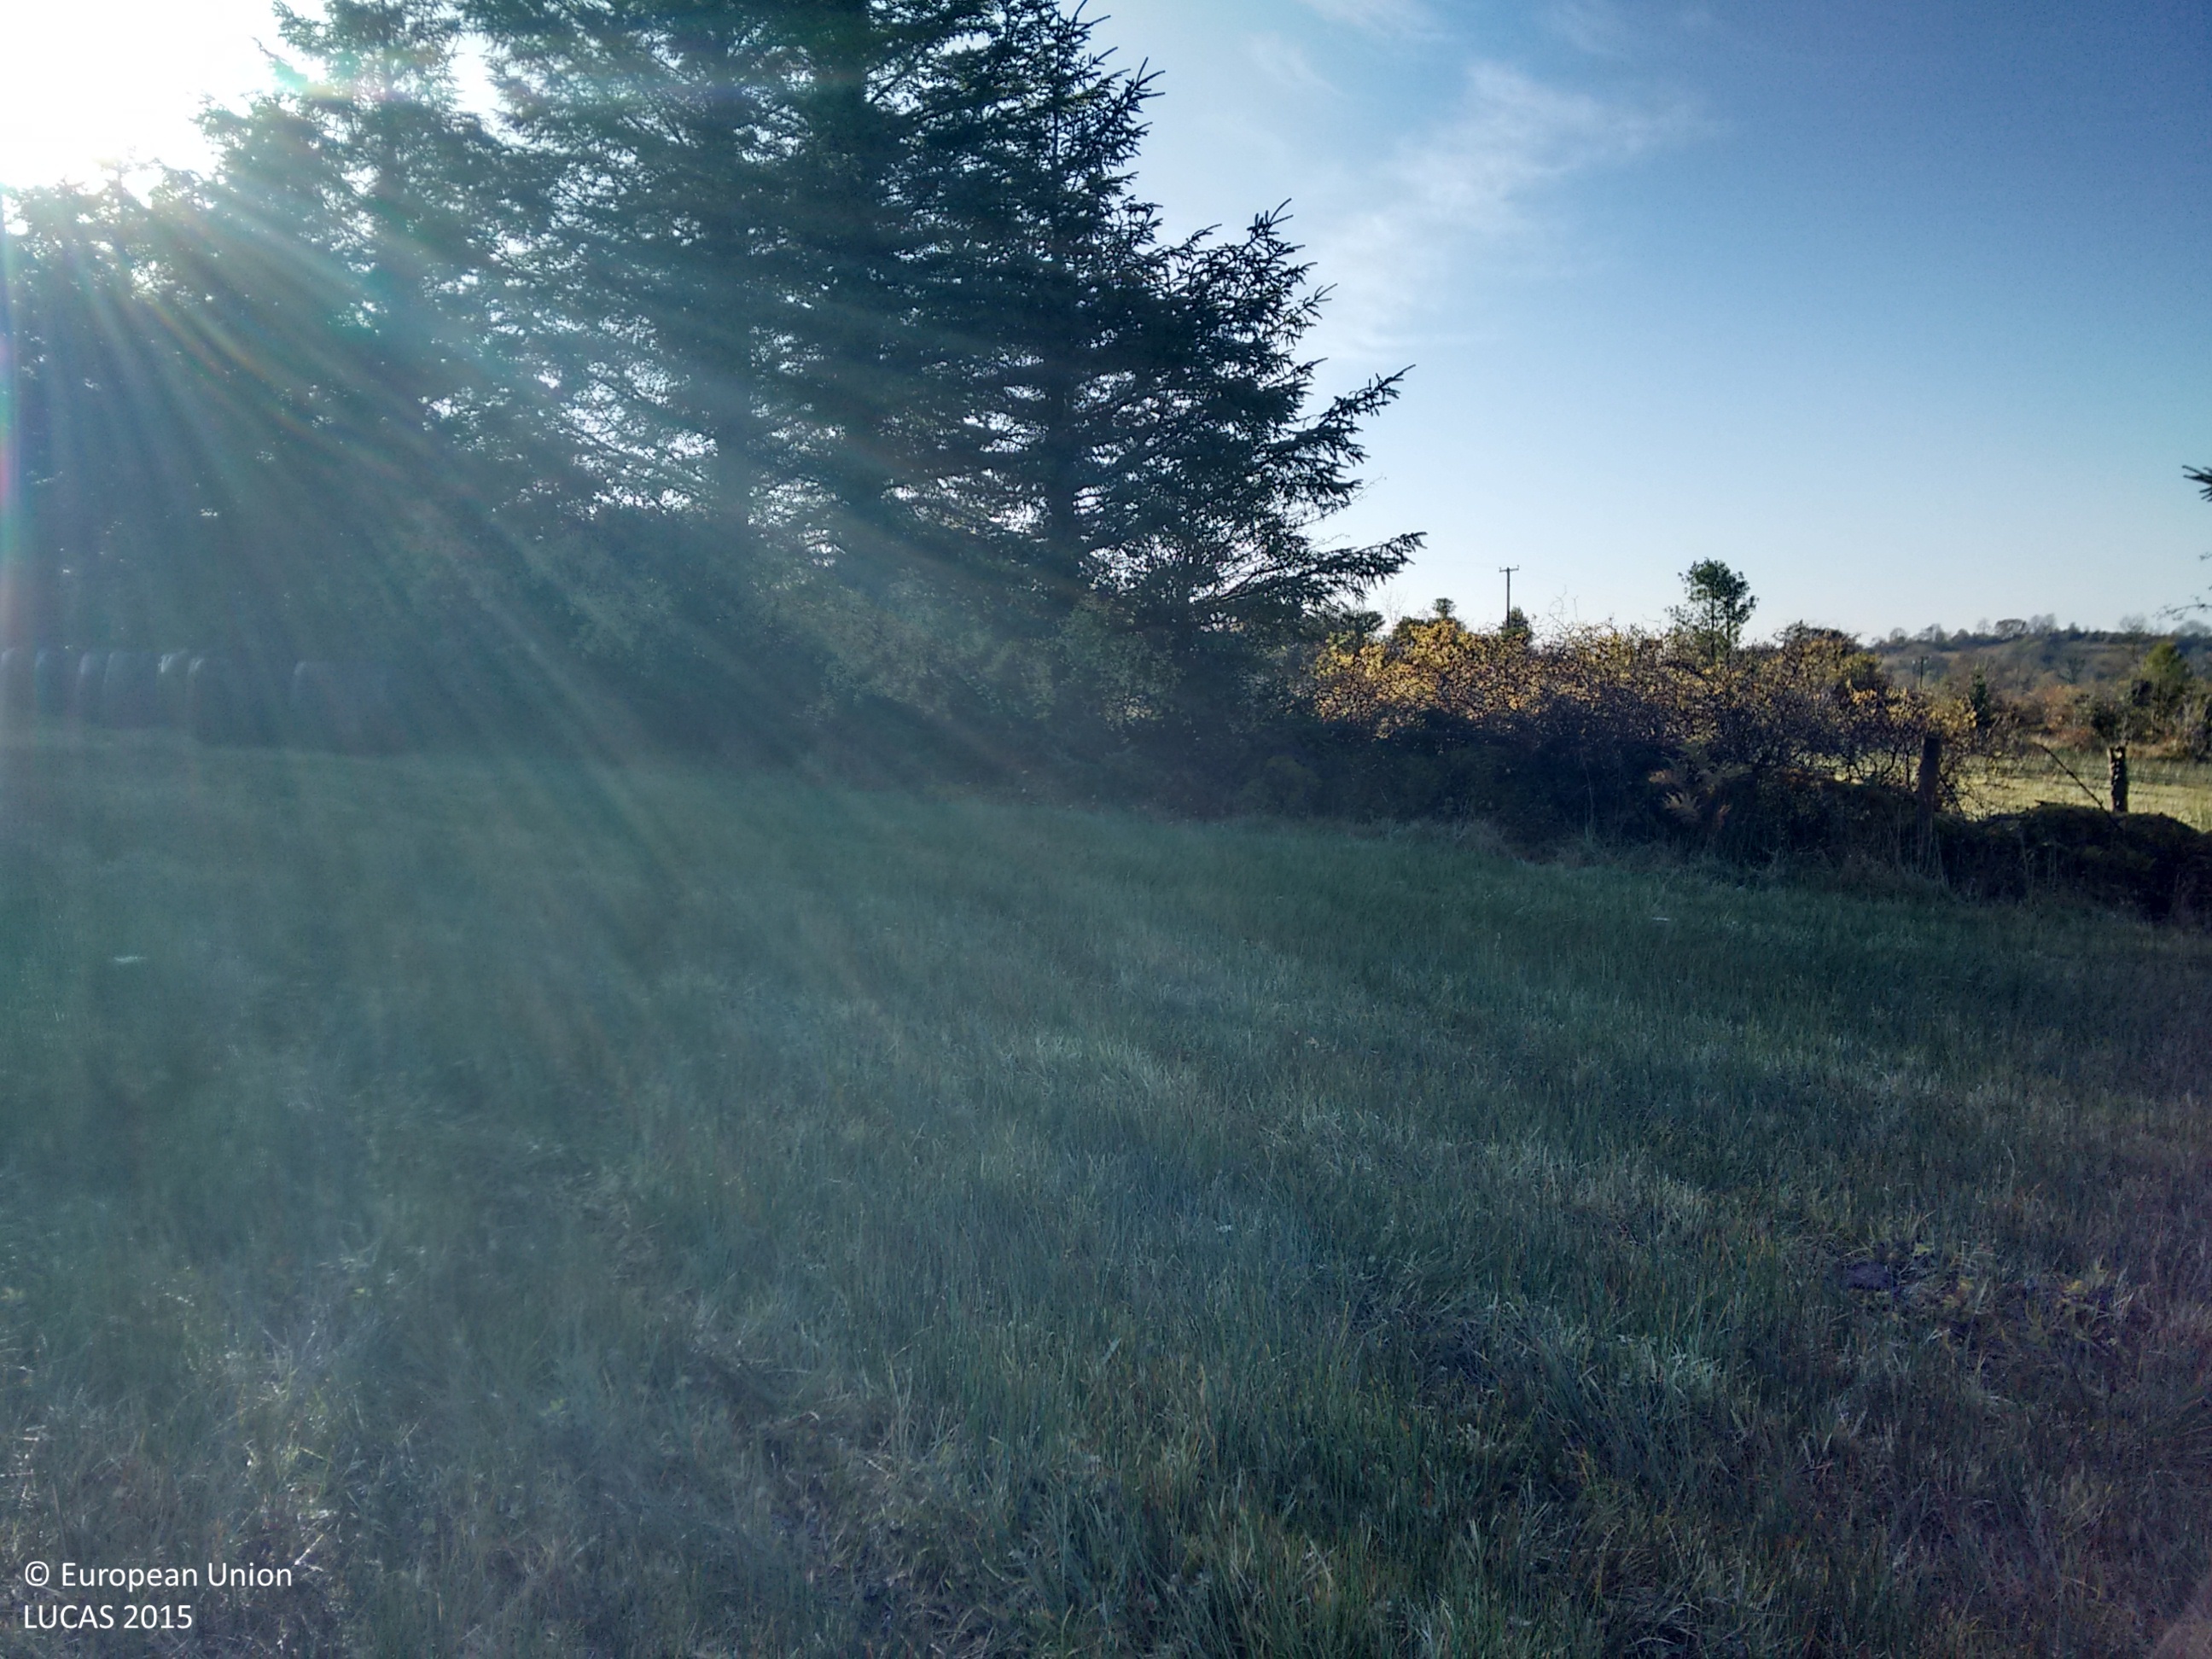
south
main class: Grassland
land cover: Grassland without tree/shrub cover
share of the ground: > 75 %
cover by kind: herbaceous plants 100 %
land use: Agriculture (excluding fallow land and kitchen gardens)
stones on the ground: < 10 %
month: October
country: IE
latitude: 54.0526
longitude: -8.0949
